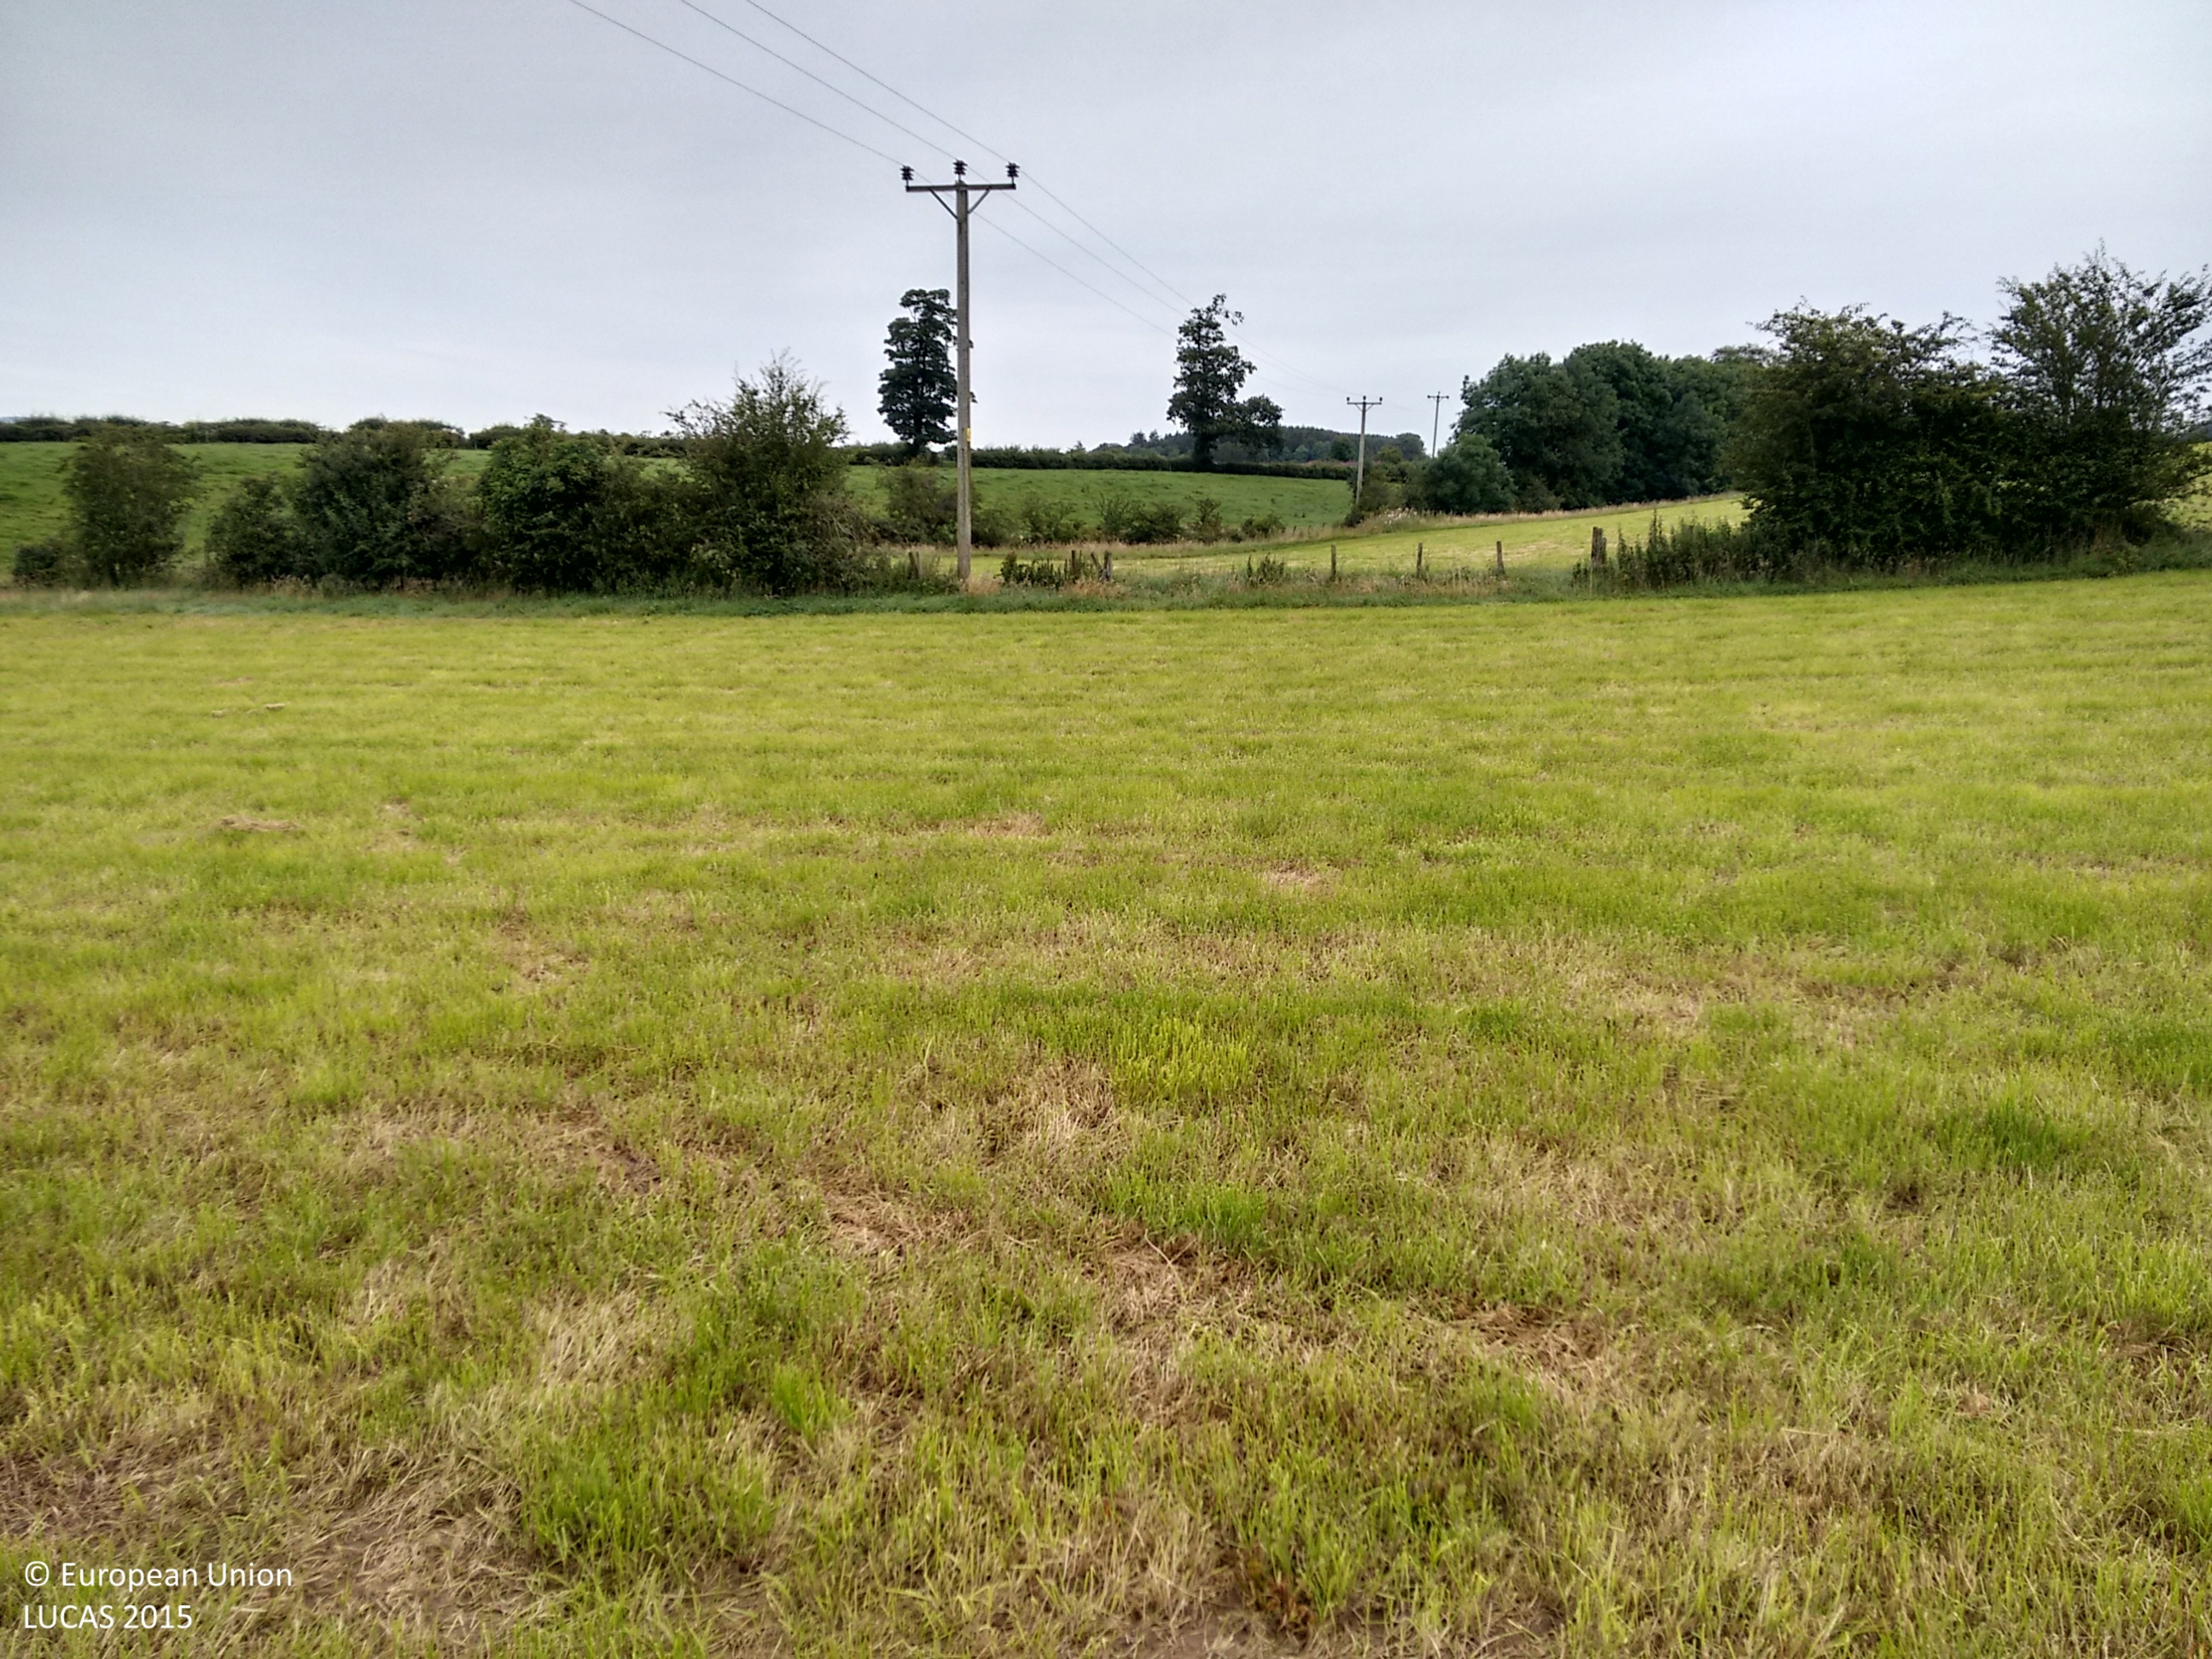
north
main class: Grassland
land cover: Grassland without tree/shrub cover
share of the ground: > 75 %
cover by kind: herbaceous plants 80 %, unconsolidated bare surface 20 %
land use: Agriculture (excluding fallow land and kitchen gardens)
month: August
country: GB
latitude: 55.1553
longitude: -3.3702
